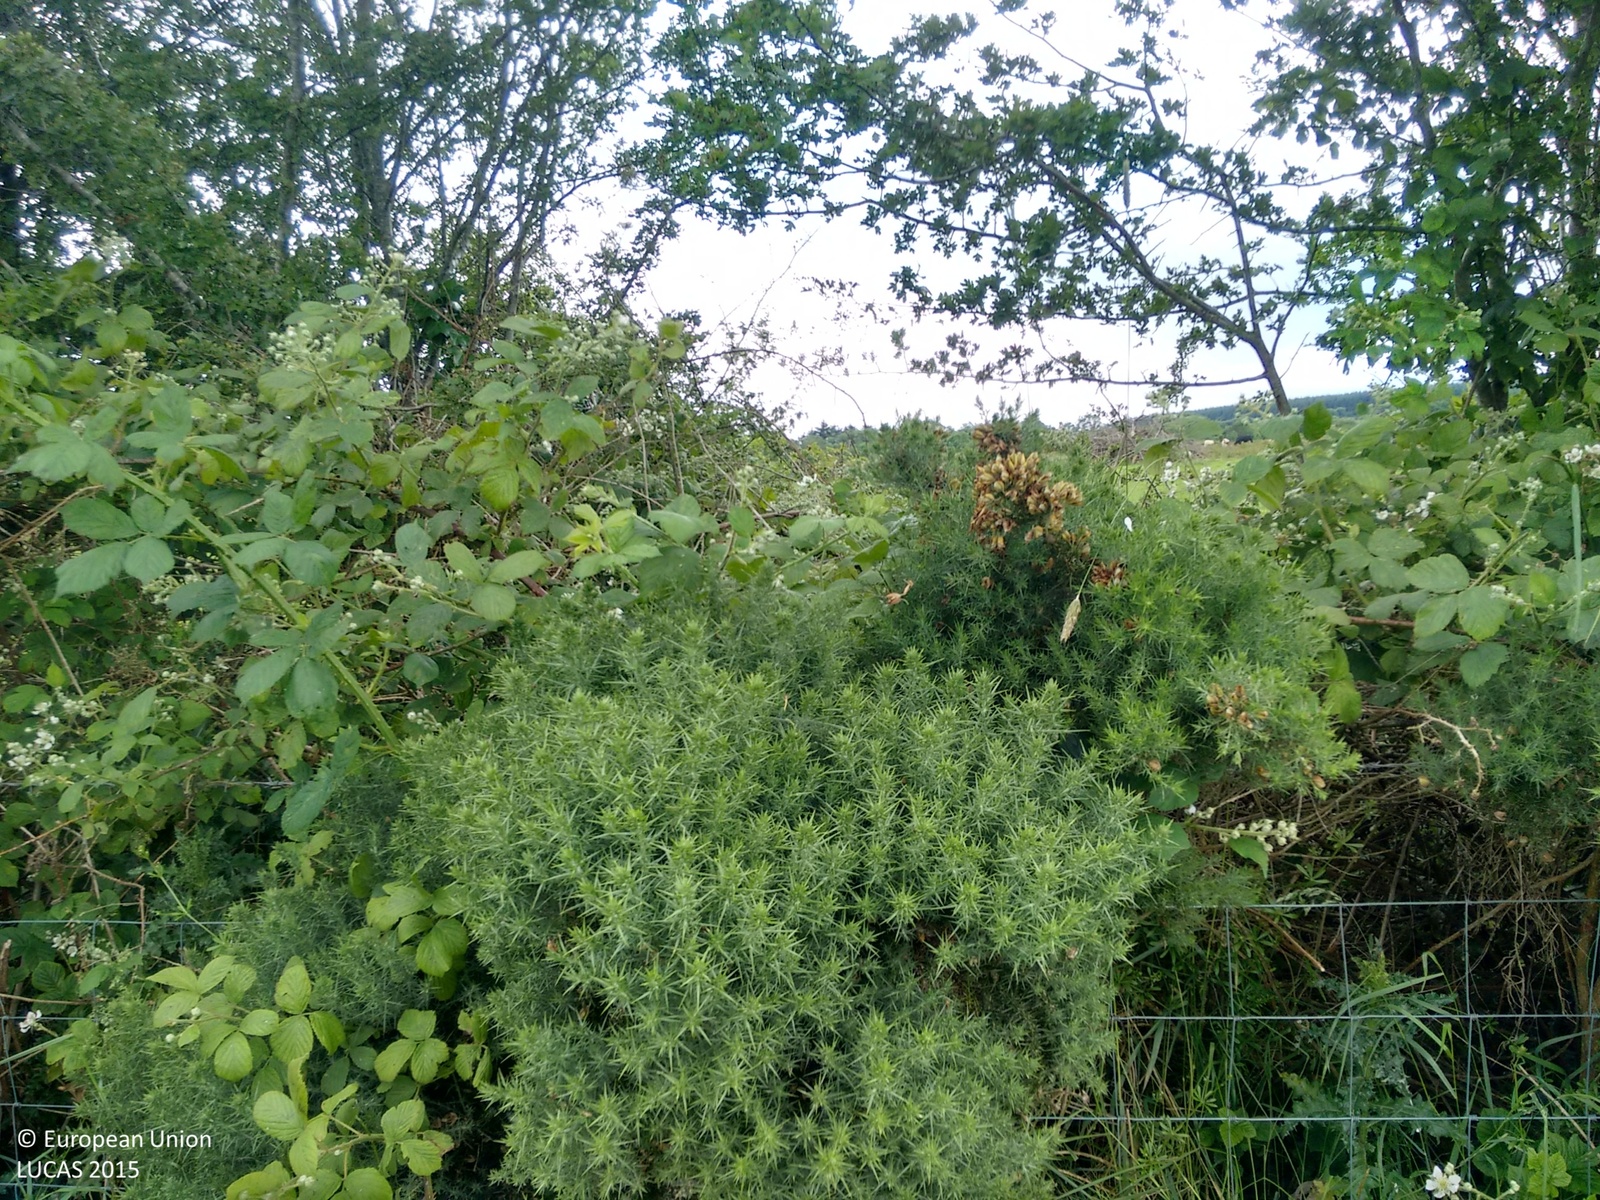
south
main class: Grassland
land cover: Grassland without tree/shrub cover
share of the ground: > 75 %
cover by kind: herbaceous plants 100 %
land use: Agriculture (excluding fallow land and kitchen gardens)
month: July
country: IE
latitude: 53.7274
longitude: -8.0462
